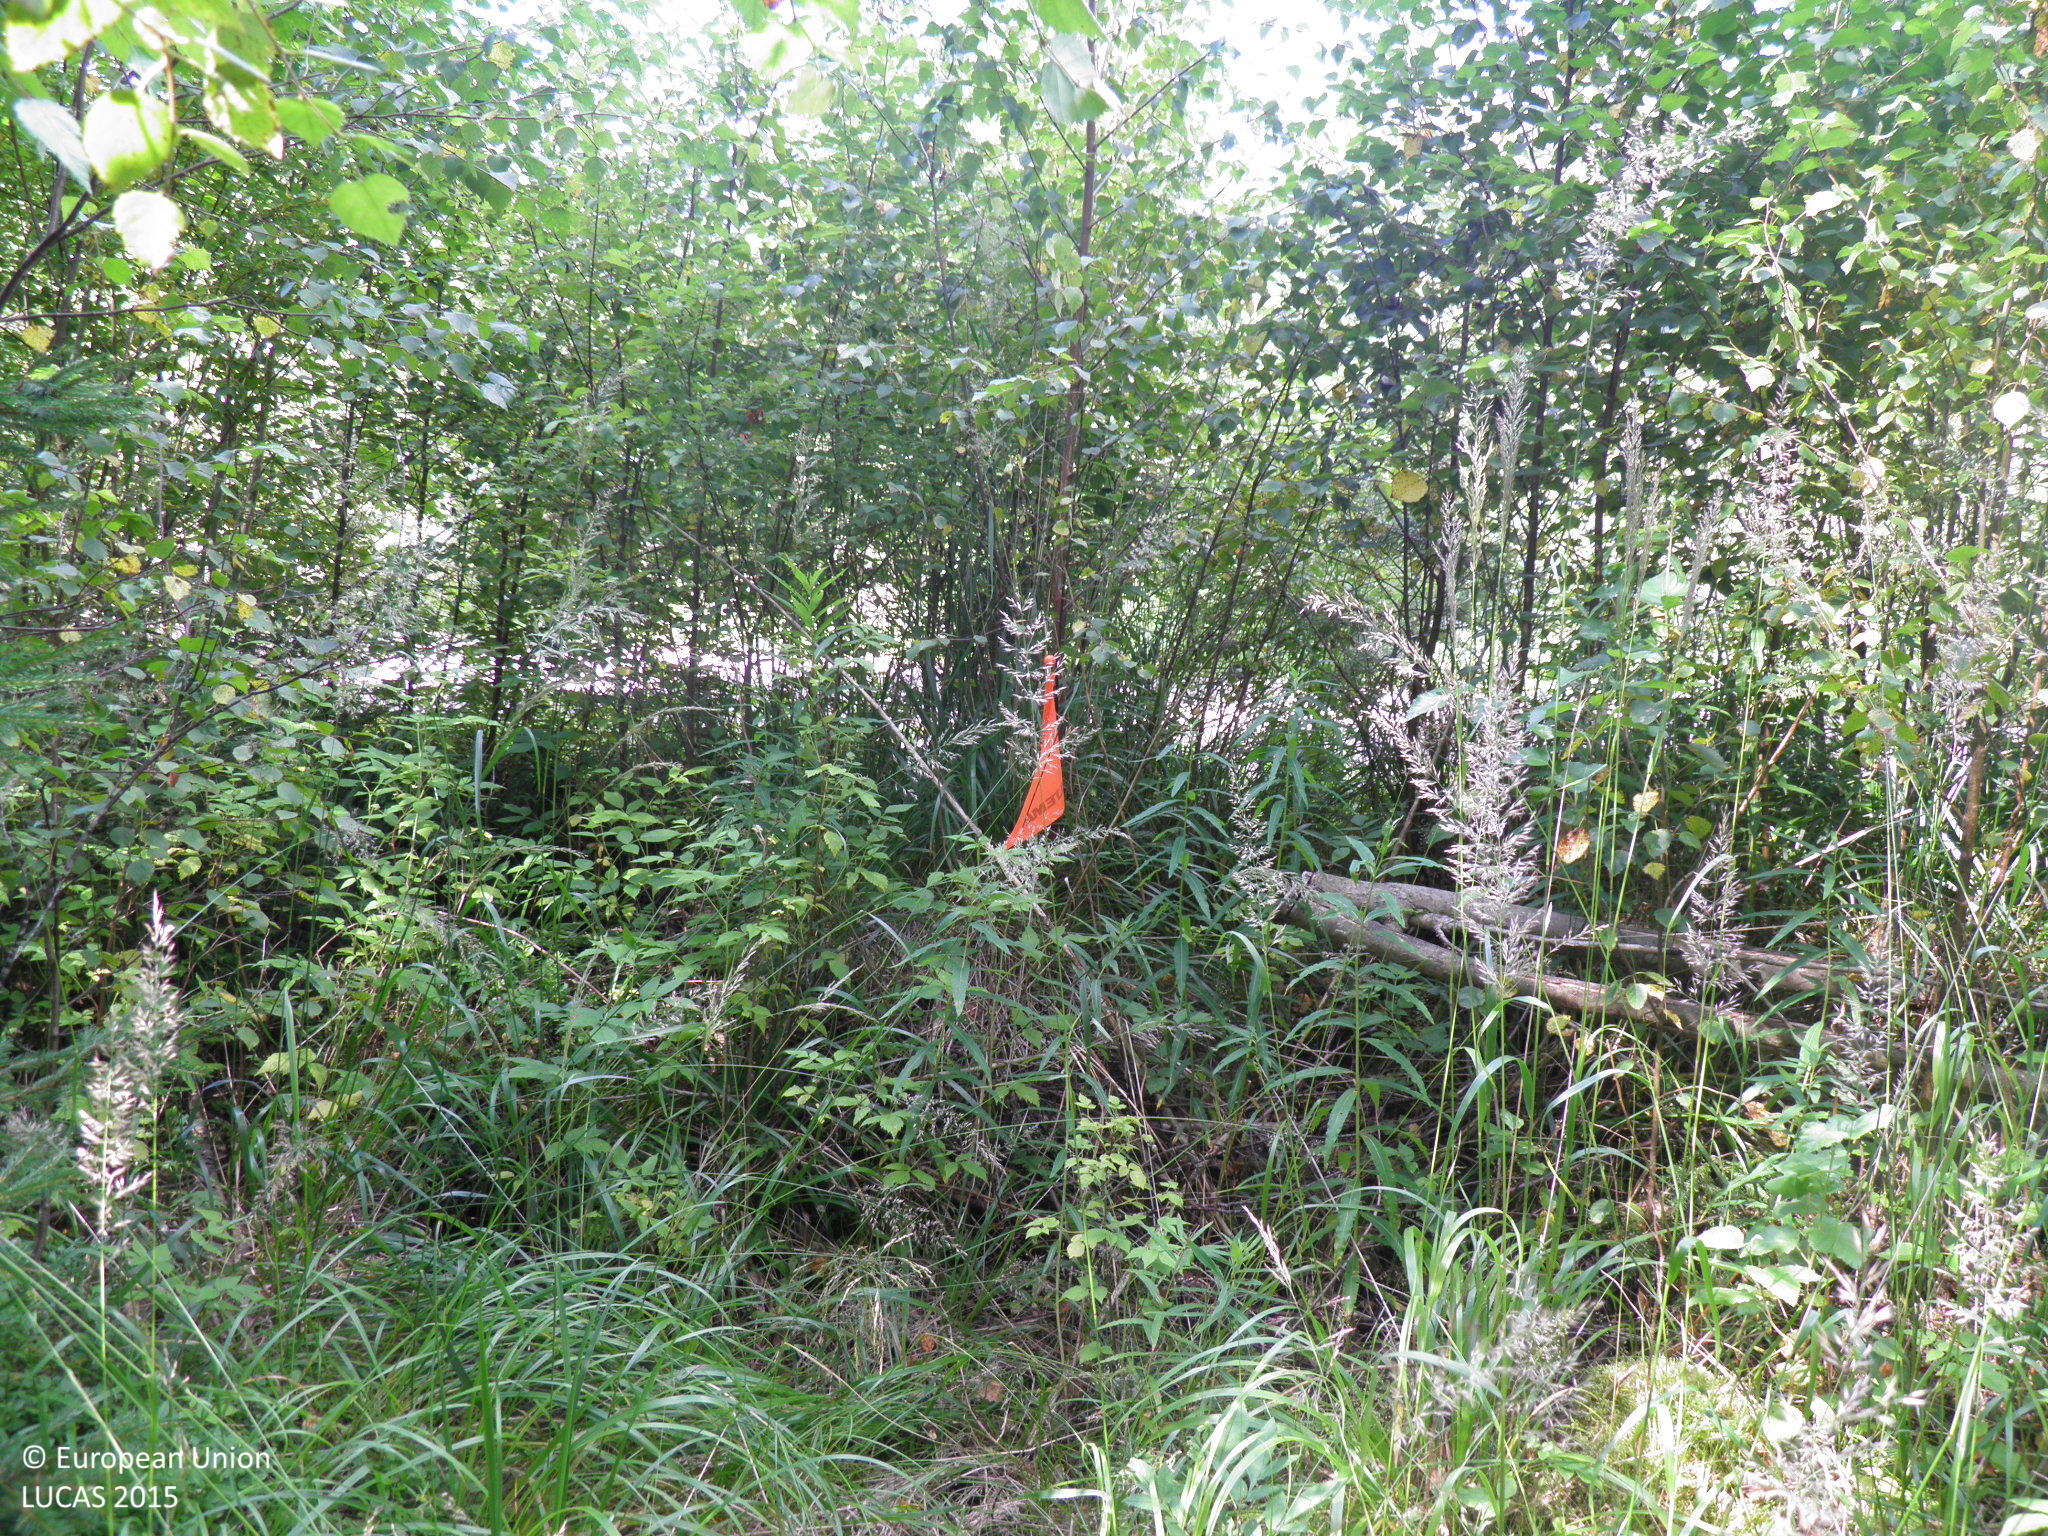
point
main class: Woodland
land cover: Pine dominated mixed woodland
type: hemiboreal forest and nemoral coniferous forest and mixed broadleaved-coniferous forest
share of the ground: 50 - 75 %
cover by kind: coniferous forest trees 40 %, broadleaved forest trees 30 %, shrubs 15 %, herbaceous plants 15 %
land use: Forestry
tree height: > 5 m
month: August
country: FI
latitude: 60.9736
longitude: 22.5011
